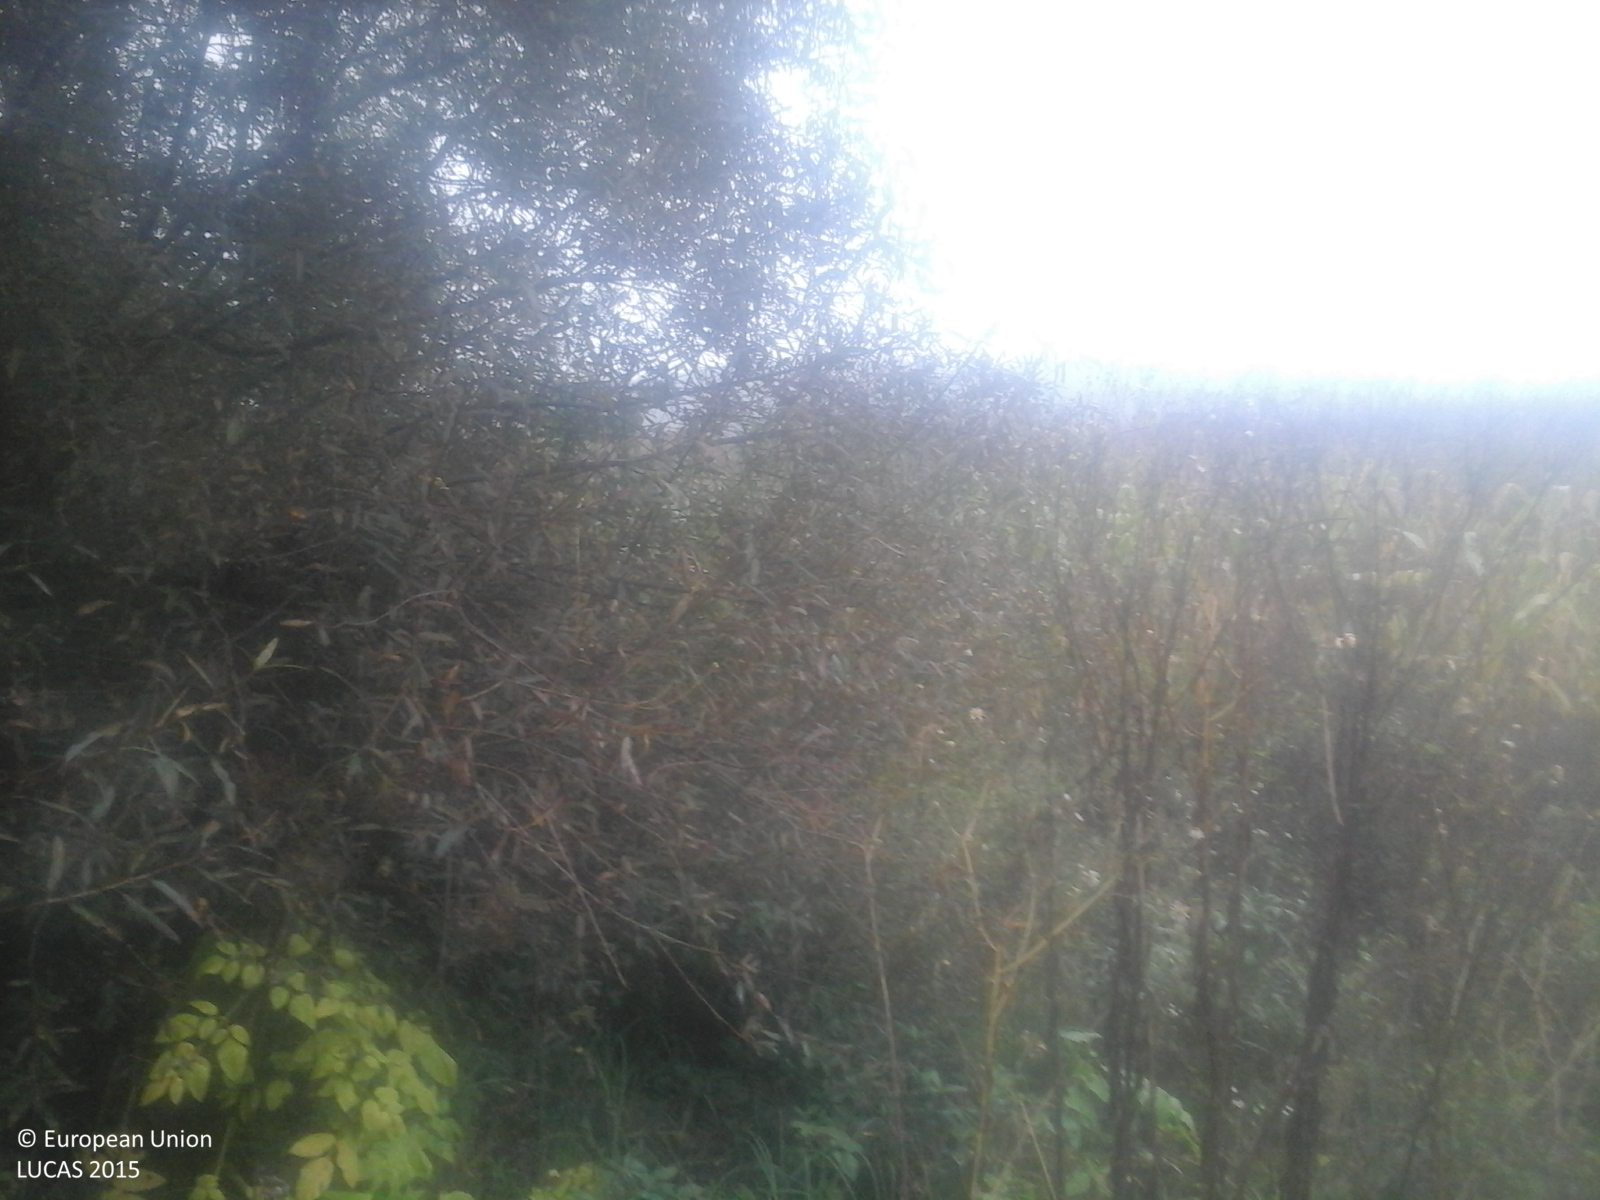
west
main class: Grassland
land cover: Spontaneously vegetated surfaces
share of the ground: > 75 %
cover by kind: herbaceous plants 100 %
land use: Fallow land
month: September
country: RO
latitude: 44.8186
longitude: 23.1901
